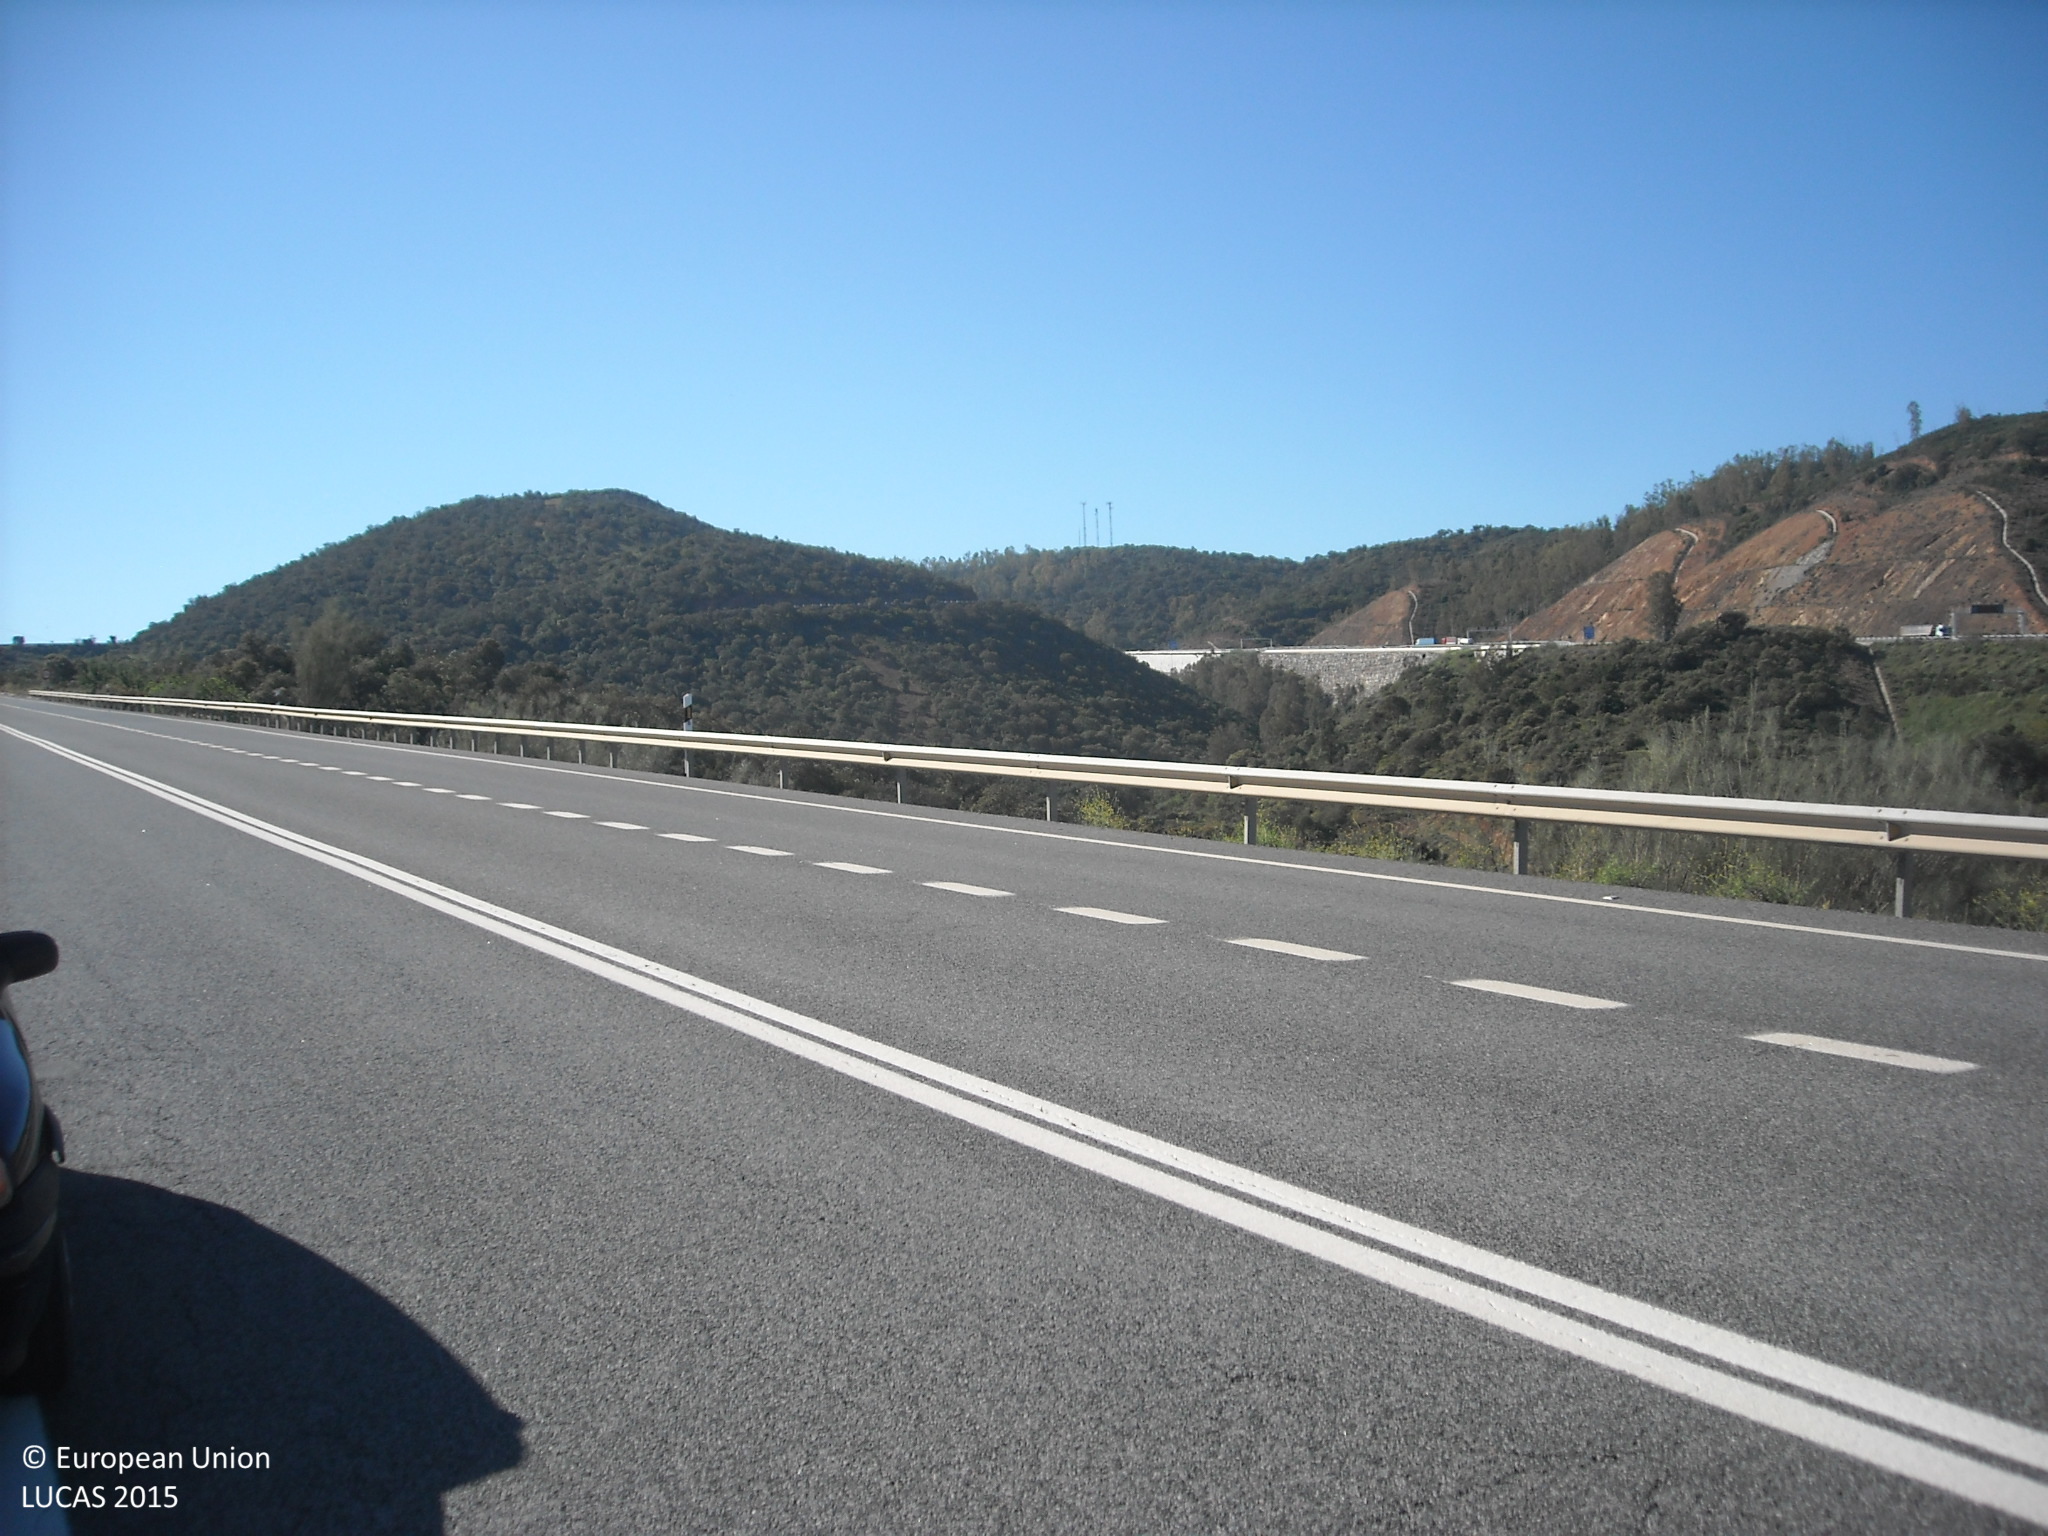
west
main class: Woodland
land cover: Broadleaved woodland
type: broadleaved evergreen forest
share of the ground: 10 - 25 %
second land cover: Grassland without tree/shrub cover
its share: > 75 %
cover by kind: herbaceous plants 75 %, broadleaved forest trees 25 %
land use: Forestry
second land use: Agriculture (excluding fallow land and kitchen gardens)
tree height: > 5 m
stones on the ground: < 10 %
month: April
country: ES
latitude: 37.6643
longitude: -6.1635
